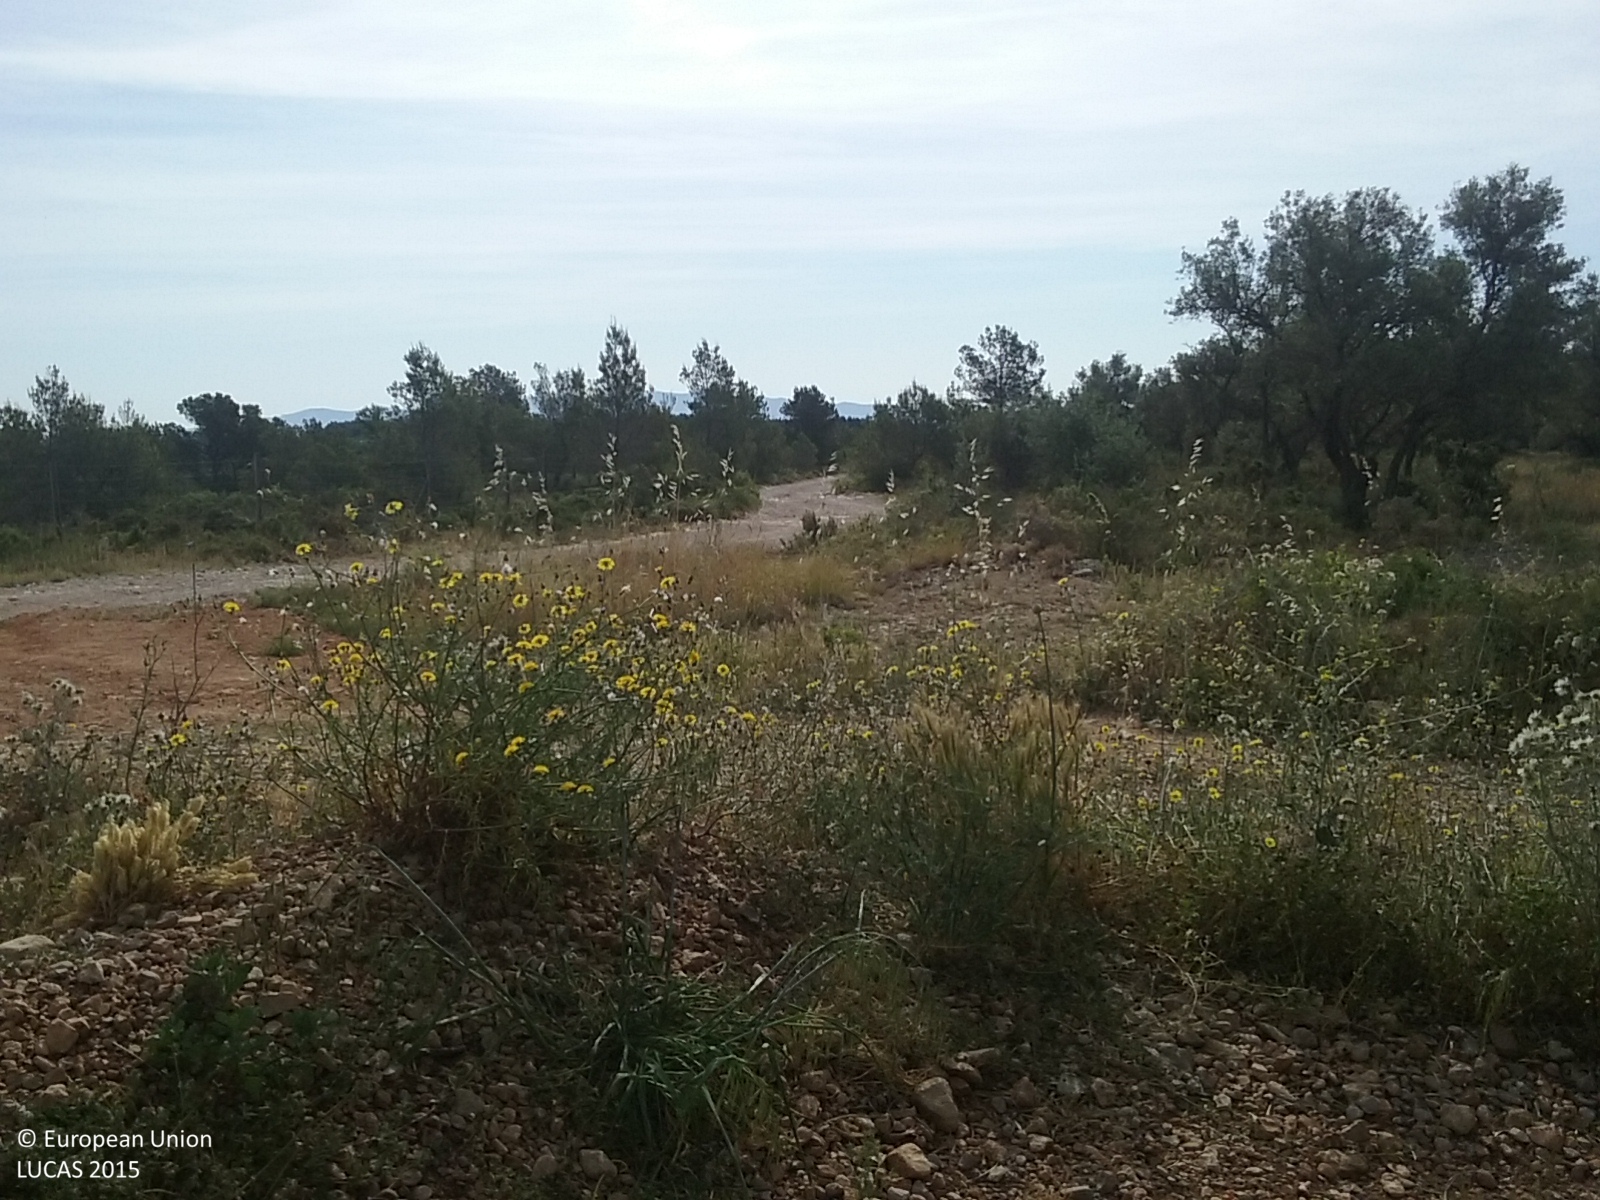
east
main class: Cropland
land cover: Olive groves
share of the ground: 25 - 50 %
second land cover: Spontaneously vegetated surfaces
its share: 25 - 50 %
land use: Agriculture (excluding fallow land and kitchen gardens)
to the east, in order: Olive groves; Spontaneously vegetated surfaces; Tracks; Grassland without tree/shrub cover; Tracks; Shruby margins; Fences; Shrubland with sparse tree cover; Pine dominated coniferous woodland; Shrubland with sparse tree cover
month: May
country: ES
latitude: 40.6221
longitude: 0.2893
